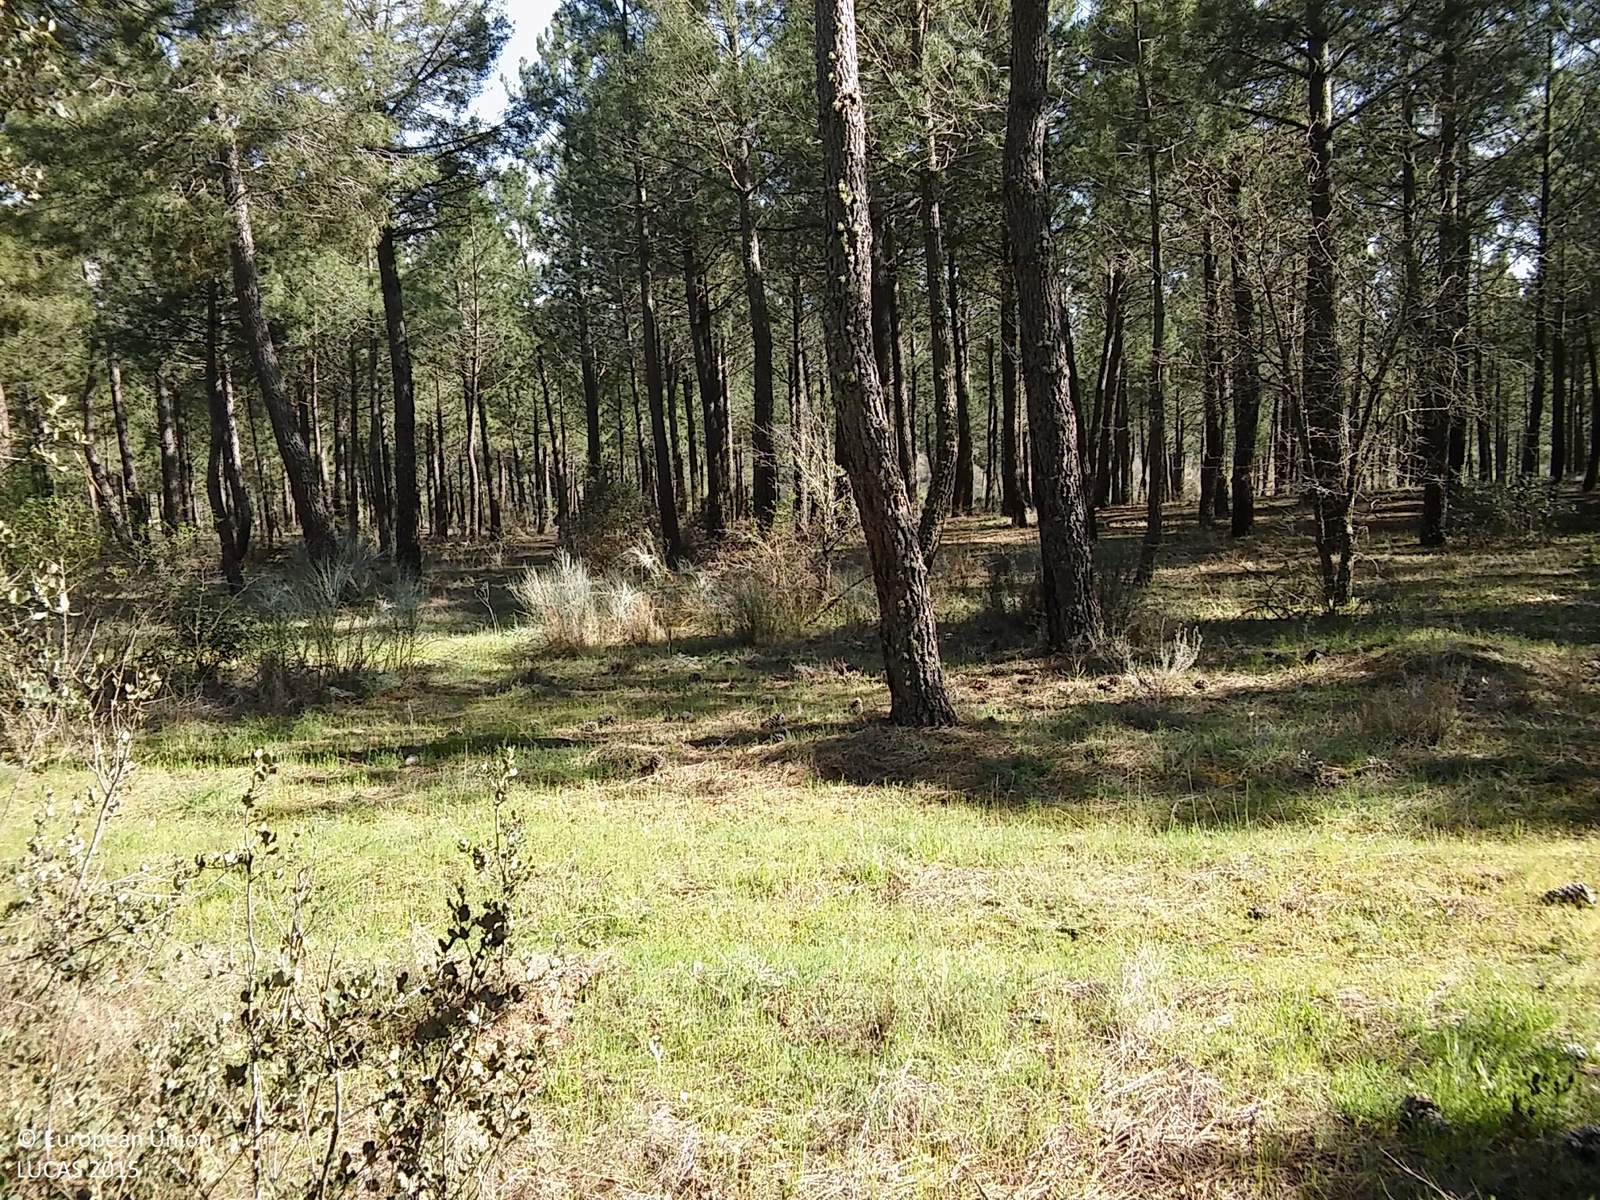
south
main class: Woodland
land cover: Pine dominated mixed woodland
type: coniferous forest of the mediterranean region
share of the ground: 25 - 50 %
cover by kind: coniferous forest trees 30 %, shrubs 20 %, broadleaved forest trees 15 %, herbaceous plants 15 %, unconsolidated bare surface 15 %, lichens and mosses 5 %
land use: Forestry
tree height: > 5 m
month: April
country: ES
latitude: 41.2767
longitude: -4.1059
